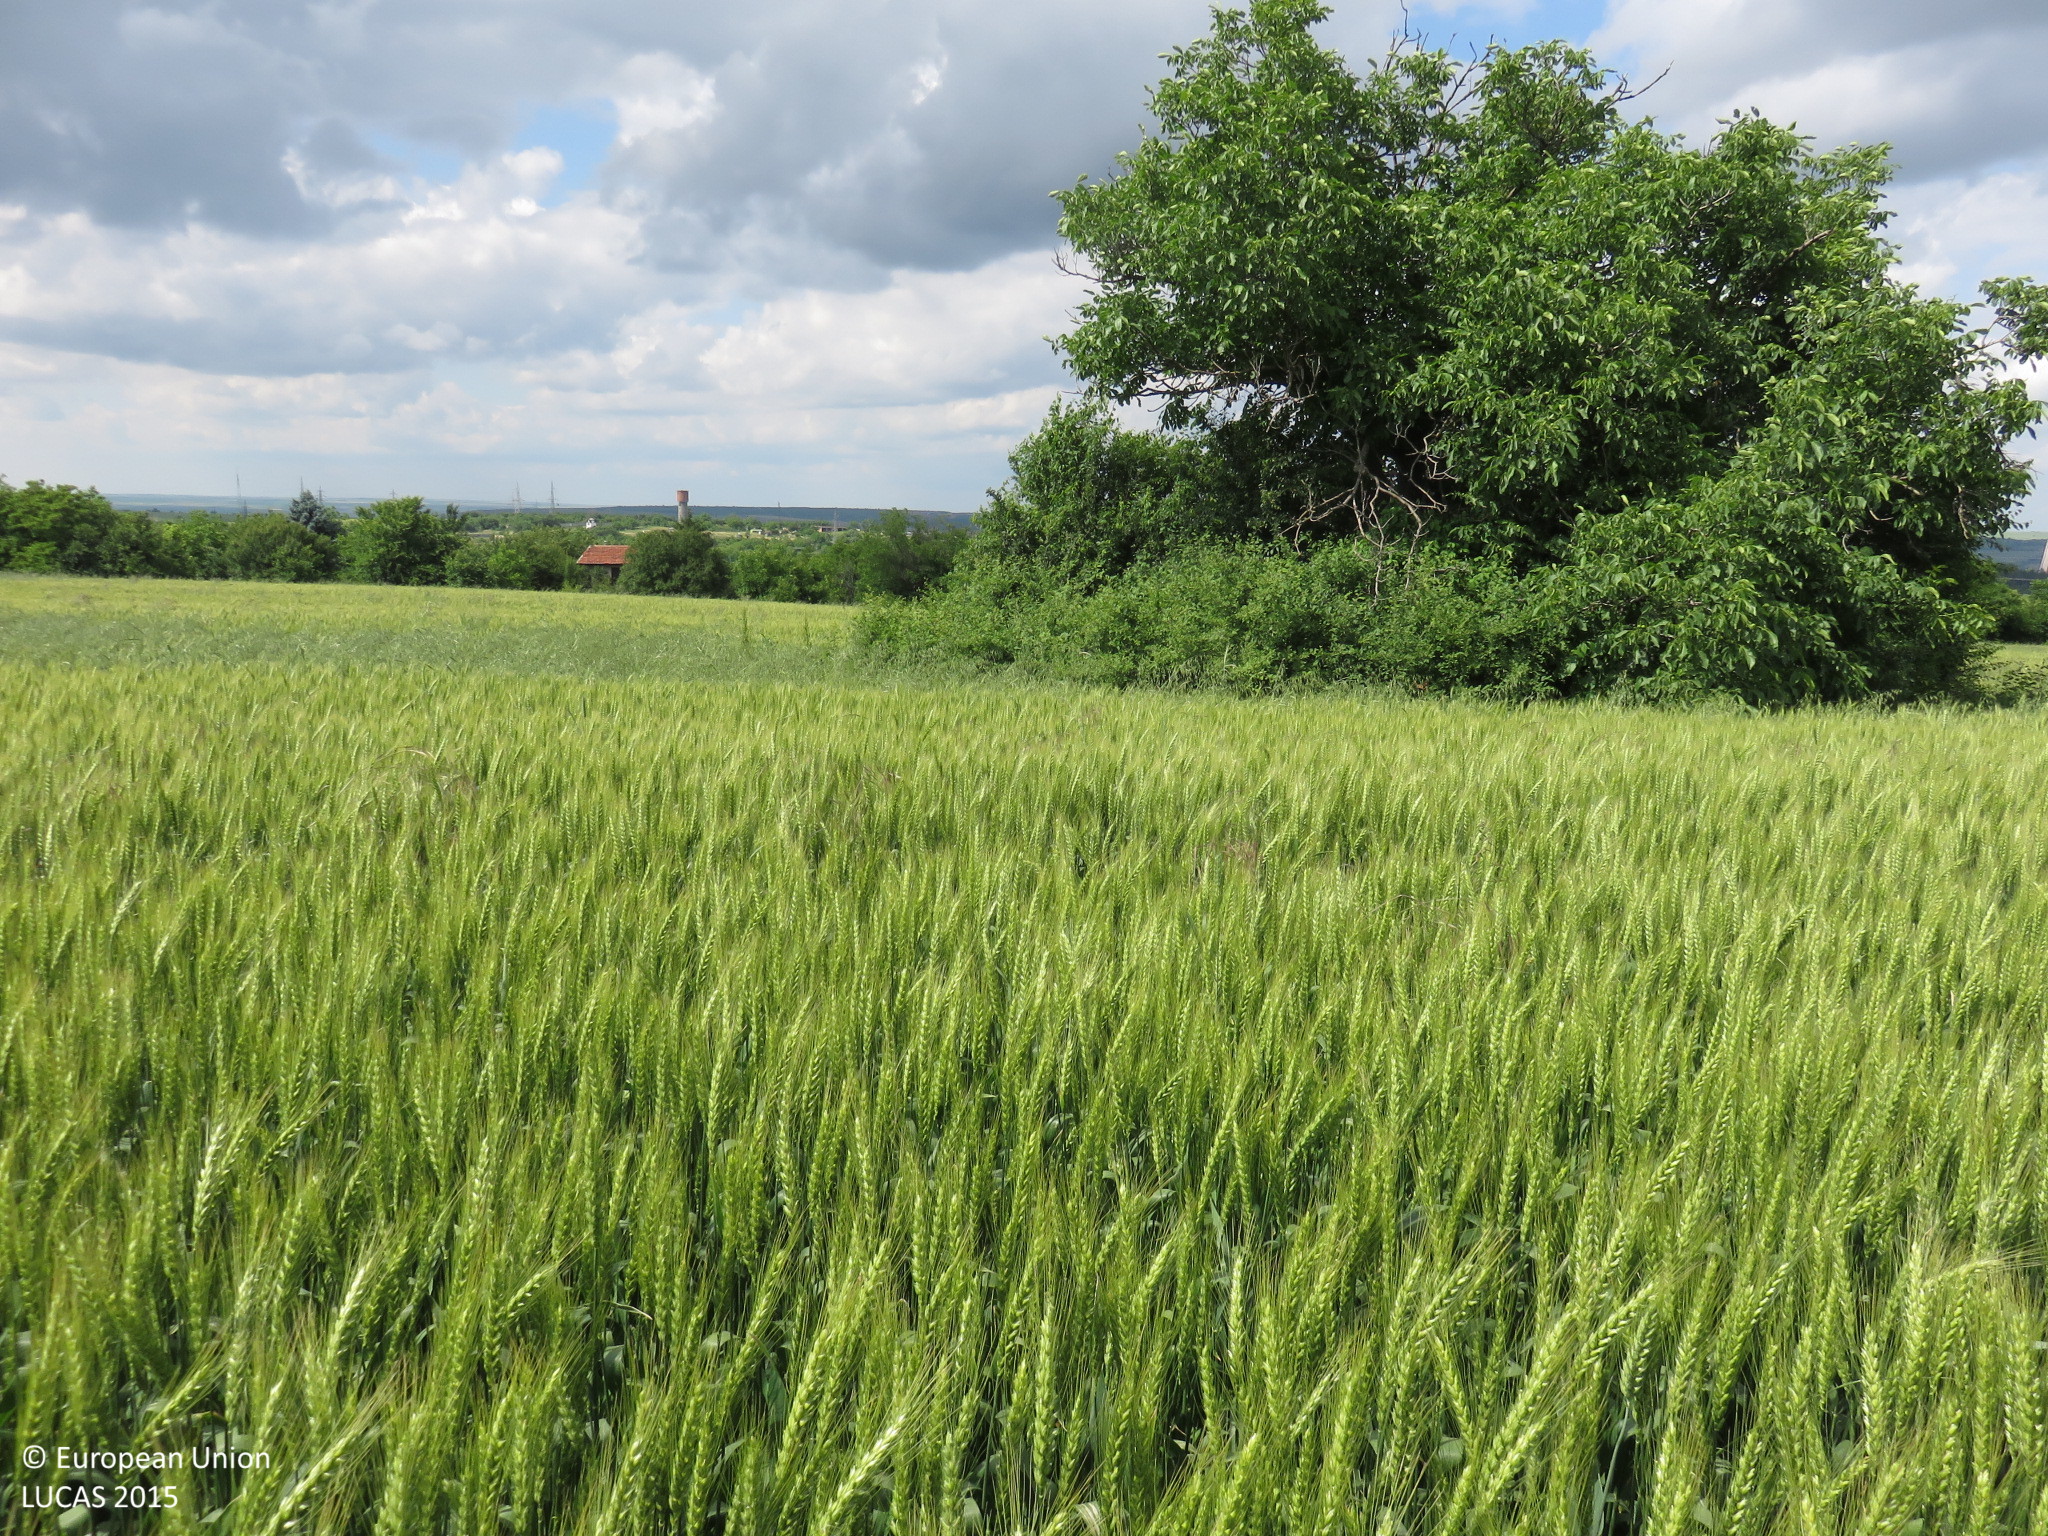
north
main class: Cropland
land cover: Common wheat
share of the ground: > 75 %
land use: Agriculture (excluding fallow land and kitchen gardens)
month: May
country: BG
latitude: 43.3859
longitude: 24.5913
